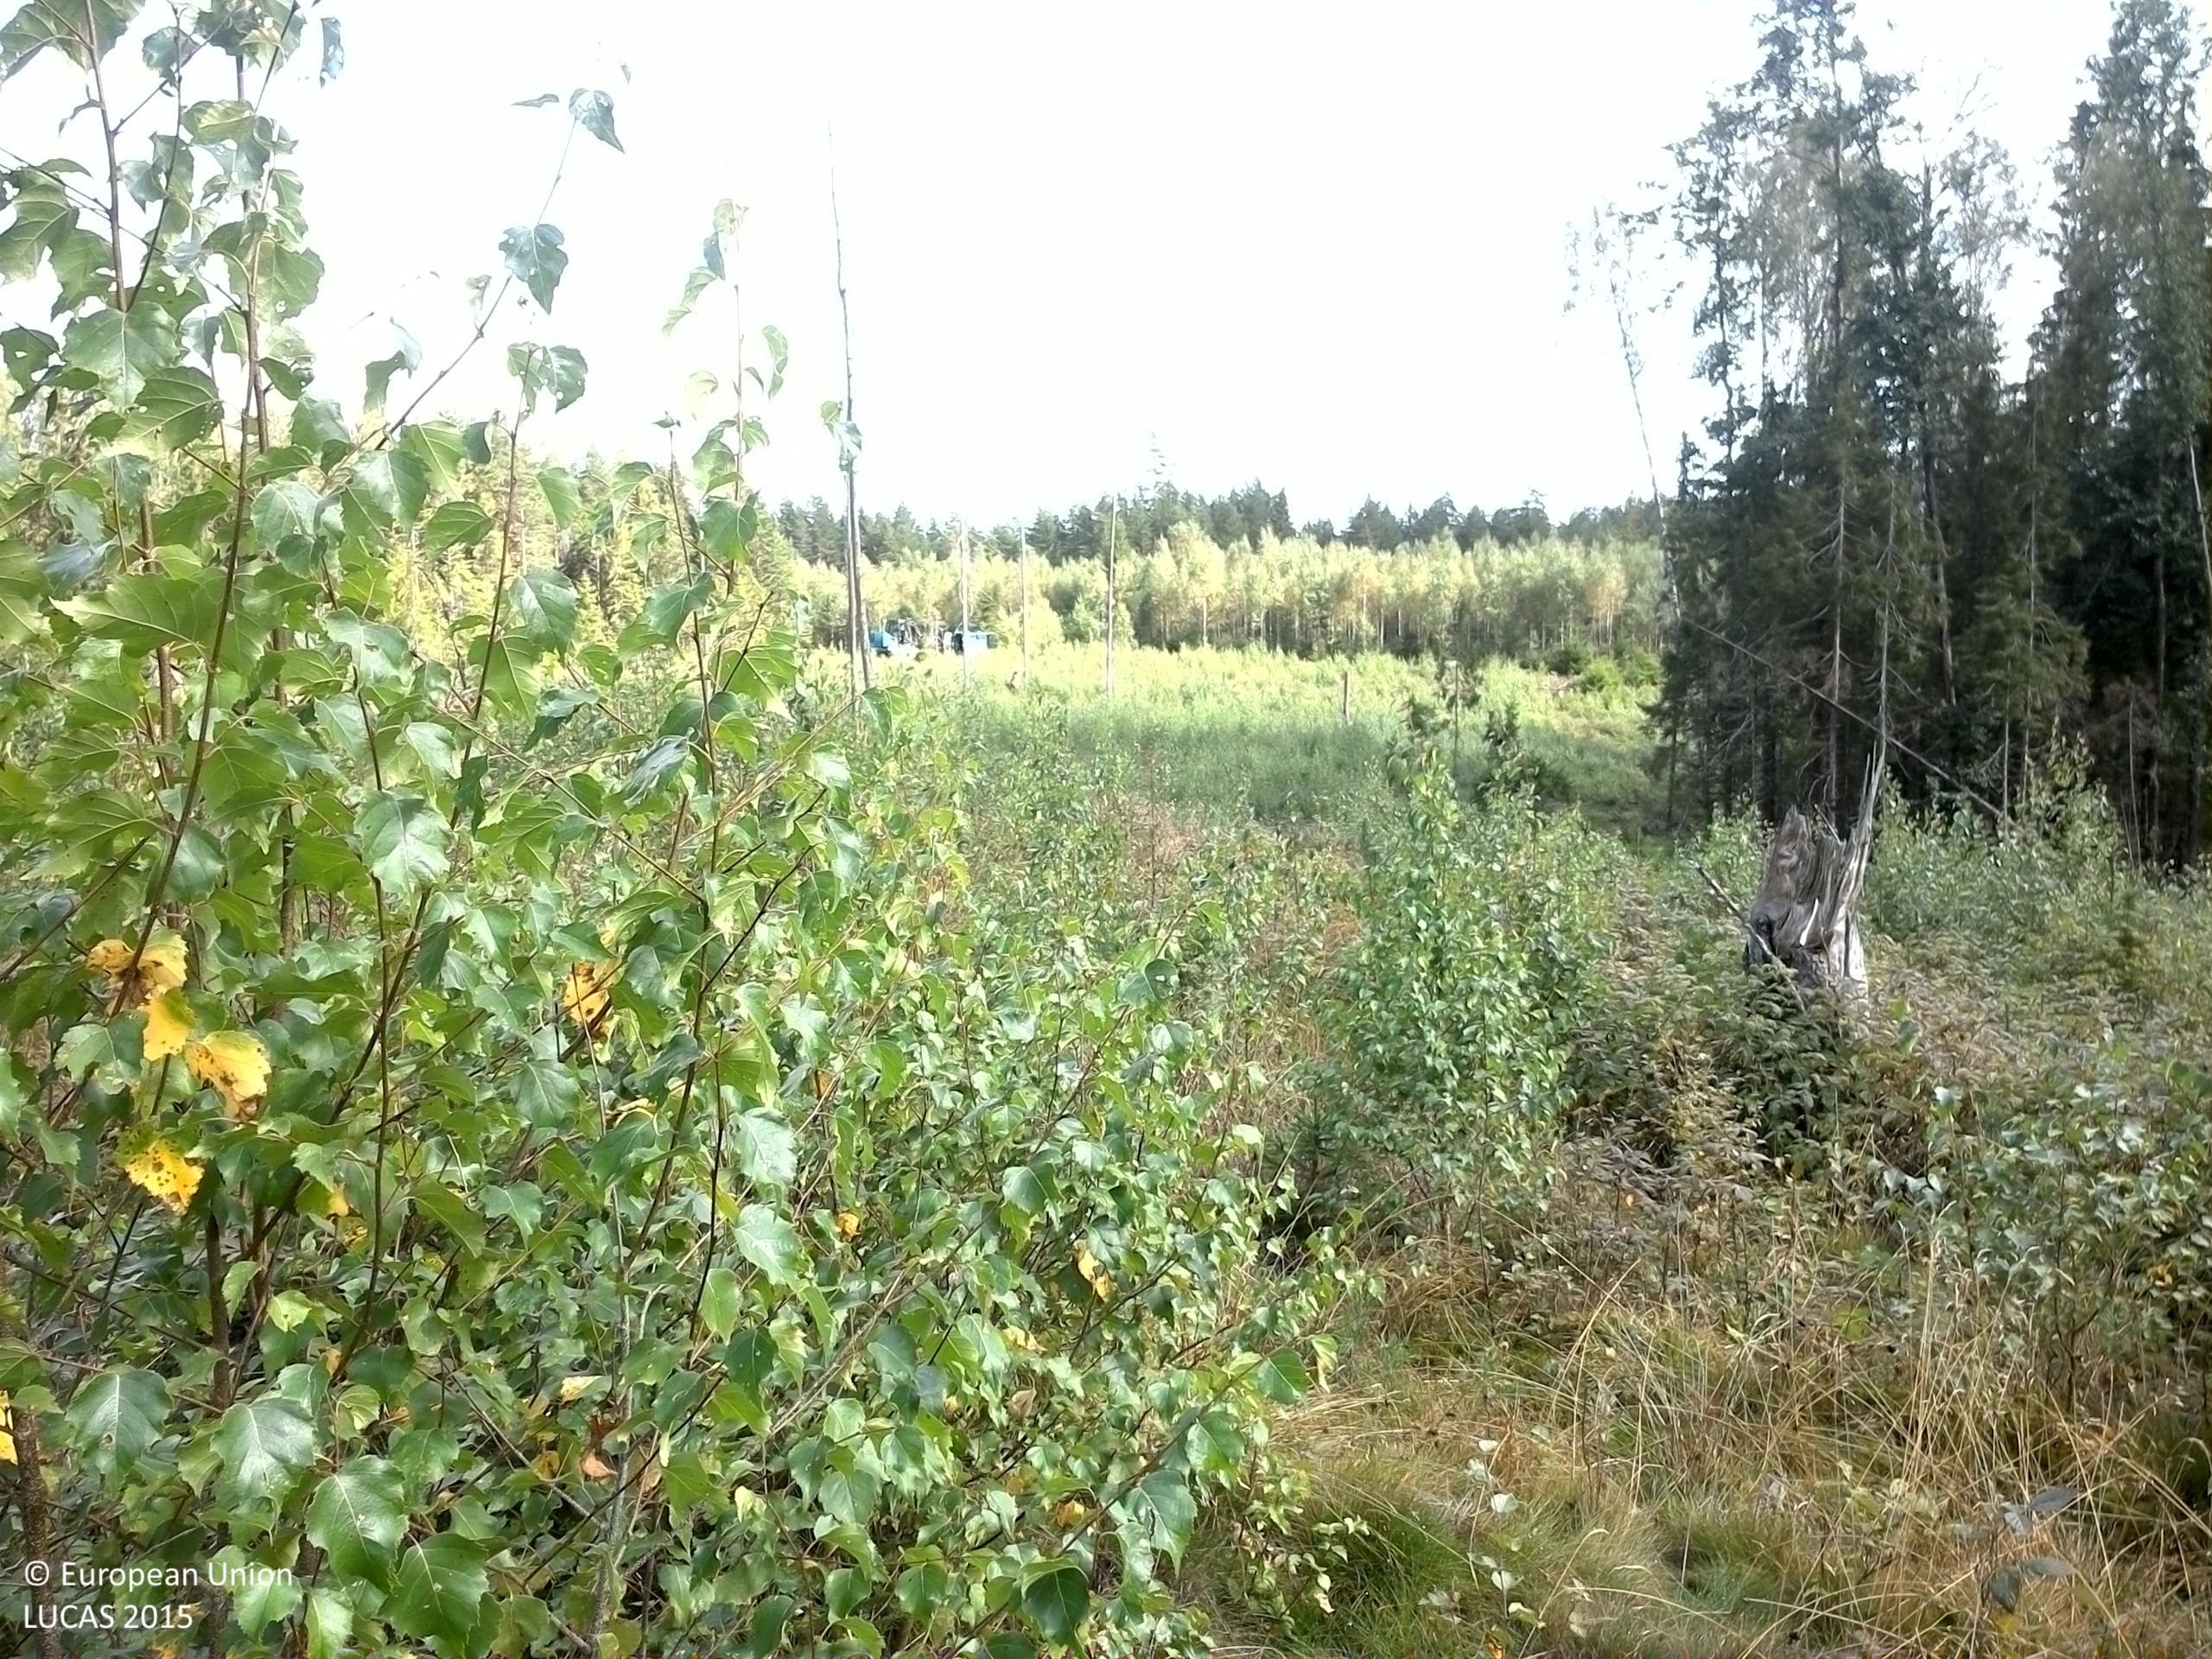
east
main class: Woodland
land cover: Spruce dominated mixed woodland
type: boreal forest
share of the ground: 25 - 50 %
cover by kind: broadleaved forest trees 30 %, shrubs 30 %, coniferous forest trees 20 %, herbaceous plants 10 %, consolidated bare surface 10 %
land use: Forestry
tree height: < 5 m
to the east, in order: Spruce dominated mixed woodland; Rivers and streams; Spruce dominated mixed woodland; Tracks; Spruce dominated mixed woodland
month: September
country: SE
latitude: 59.3206
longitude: 11.9805
